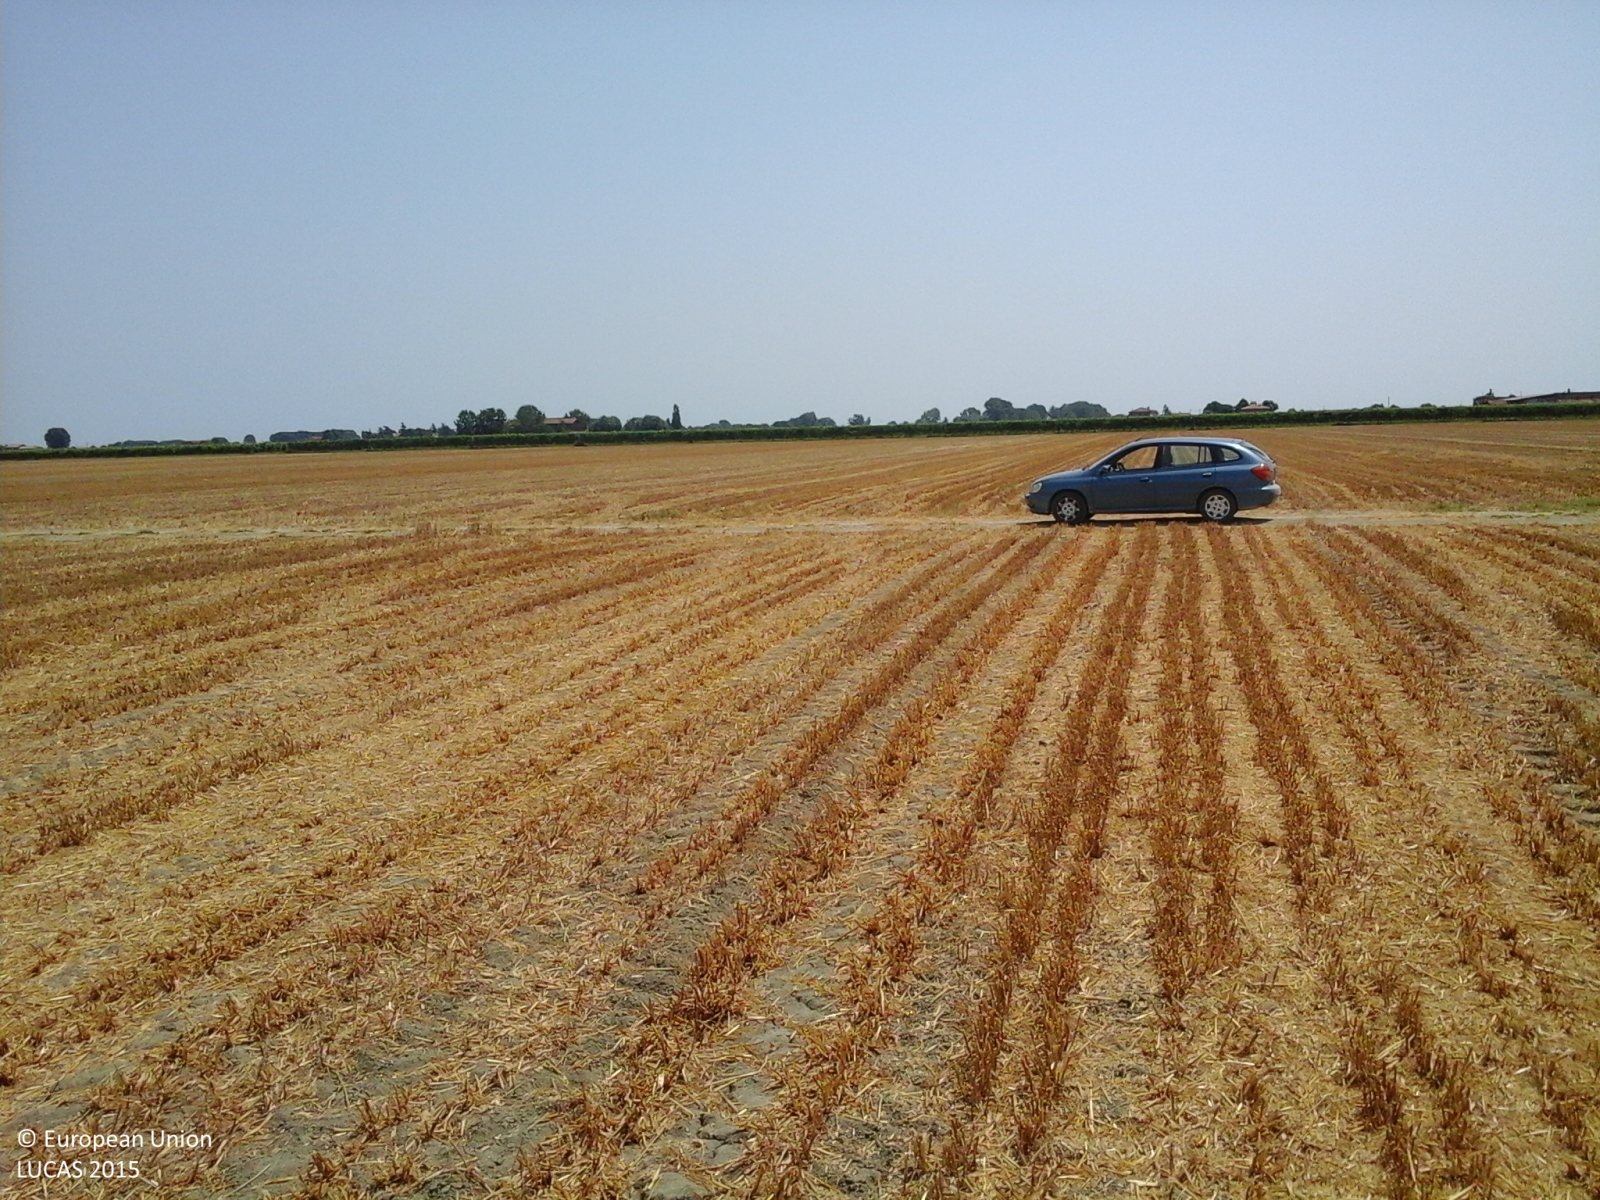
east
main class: Cropland
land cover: Common wheat
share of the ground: > 75 %
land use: Agriculture (excluding fallow land and kitchen gardens)
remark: Harvested field
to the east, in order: Common wheat; Tracks; Common wheat
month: July
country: IT
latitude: 44.4450
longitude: 11.6926
